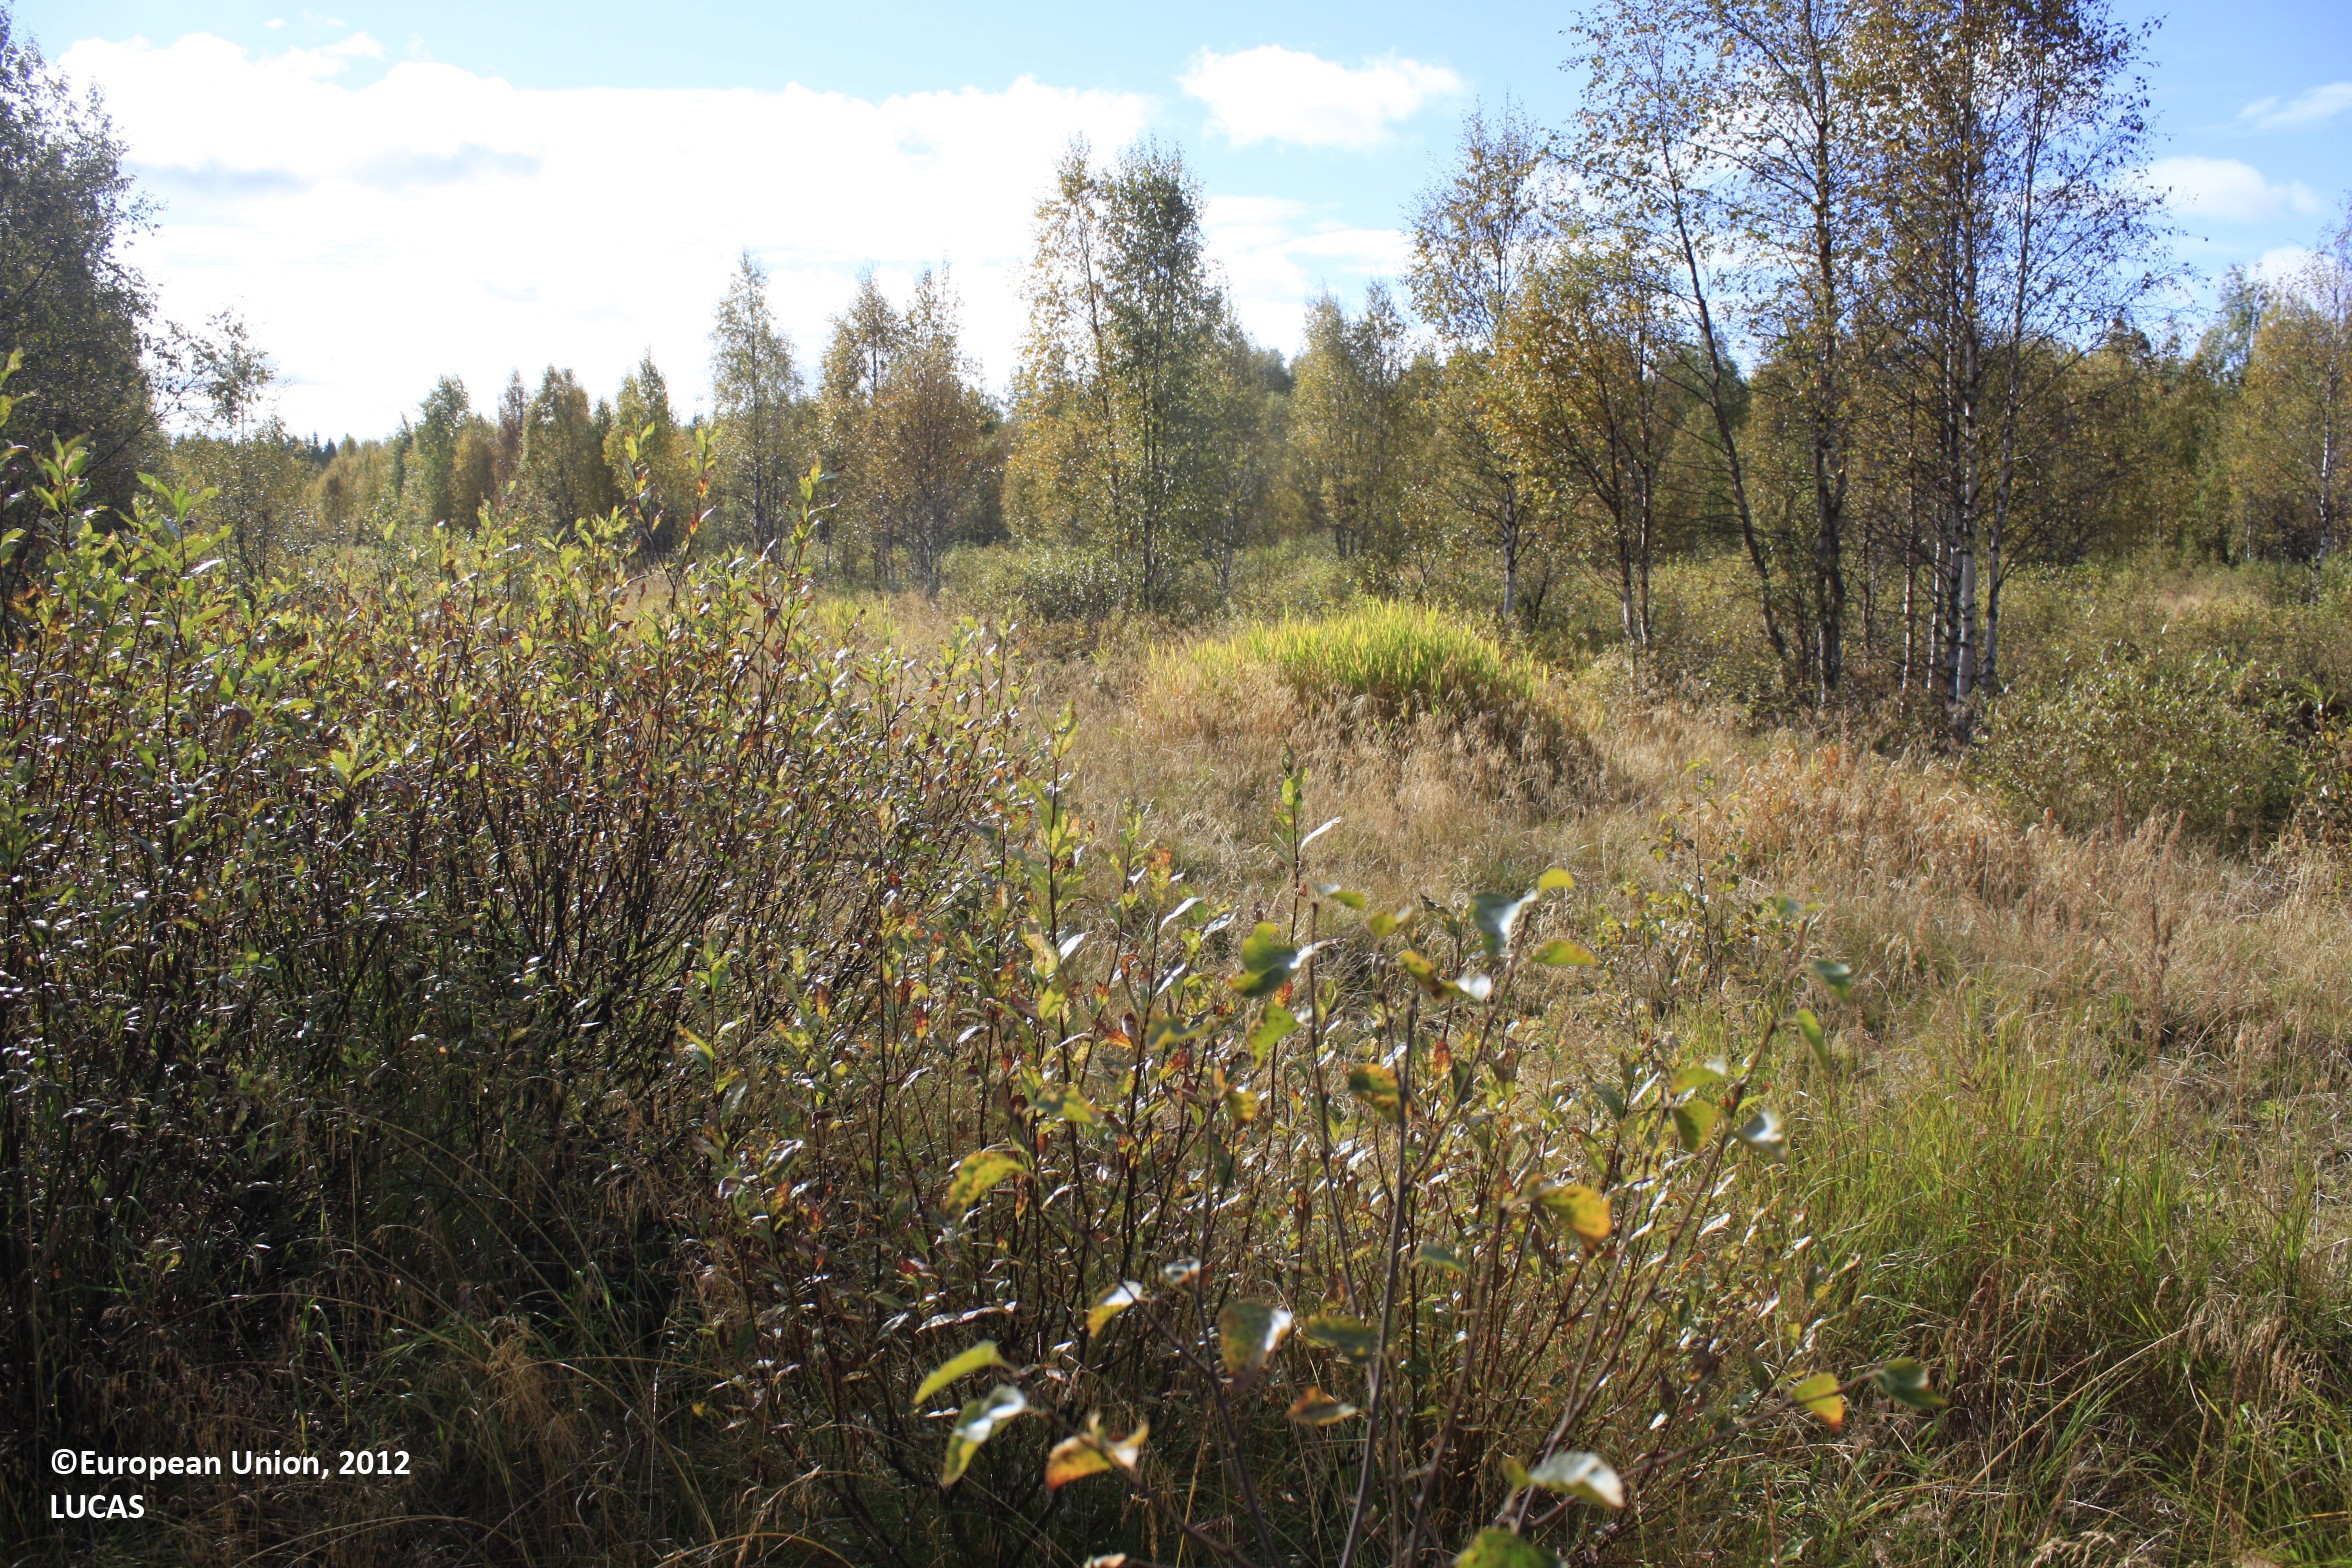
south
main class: Woodland
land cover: Broadleaved woodland
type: boreal forest
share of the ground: 25 - 50 %
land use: Forestry
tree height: < 5 m
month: September
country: FI
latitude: 65.6364
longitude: 26.5462
